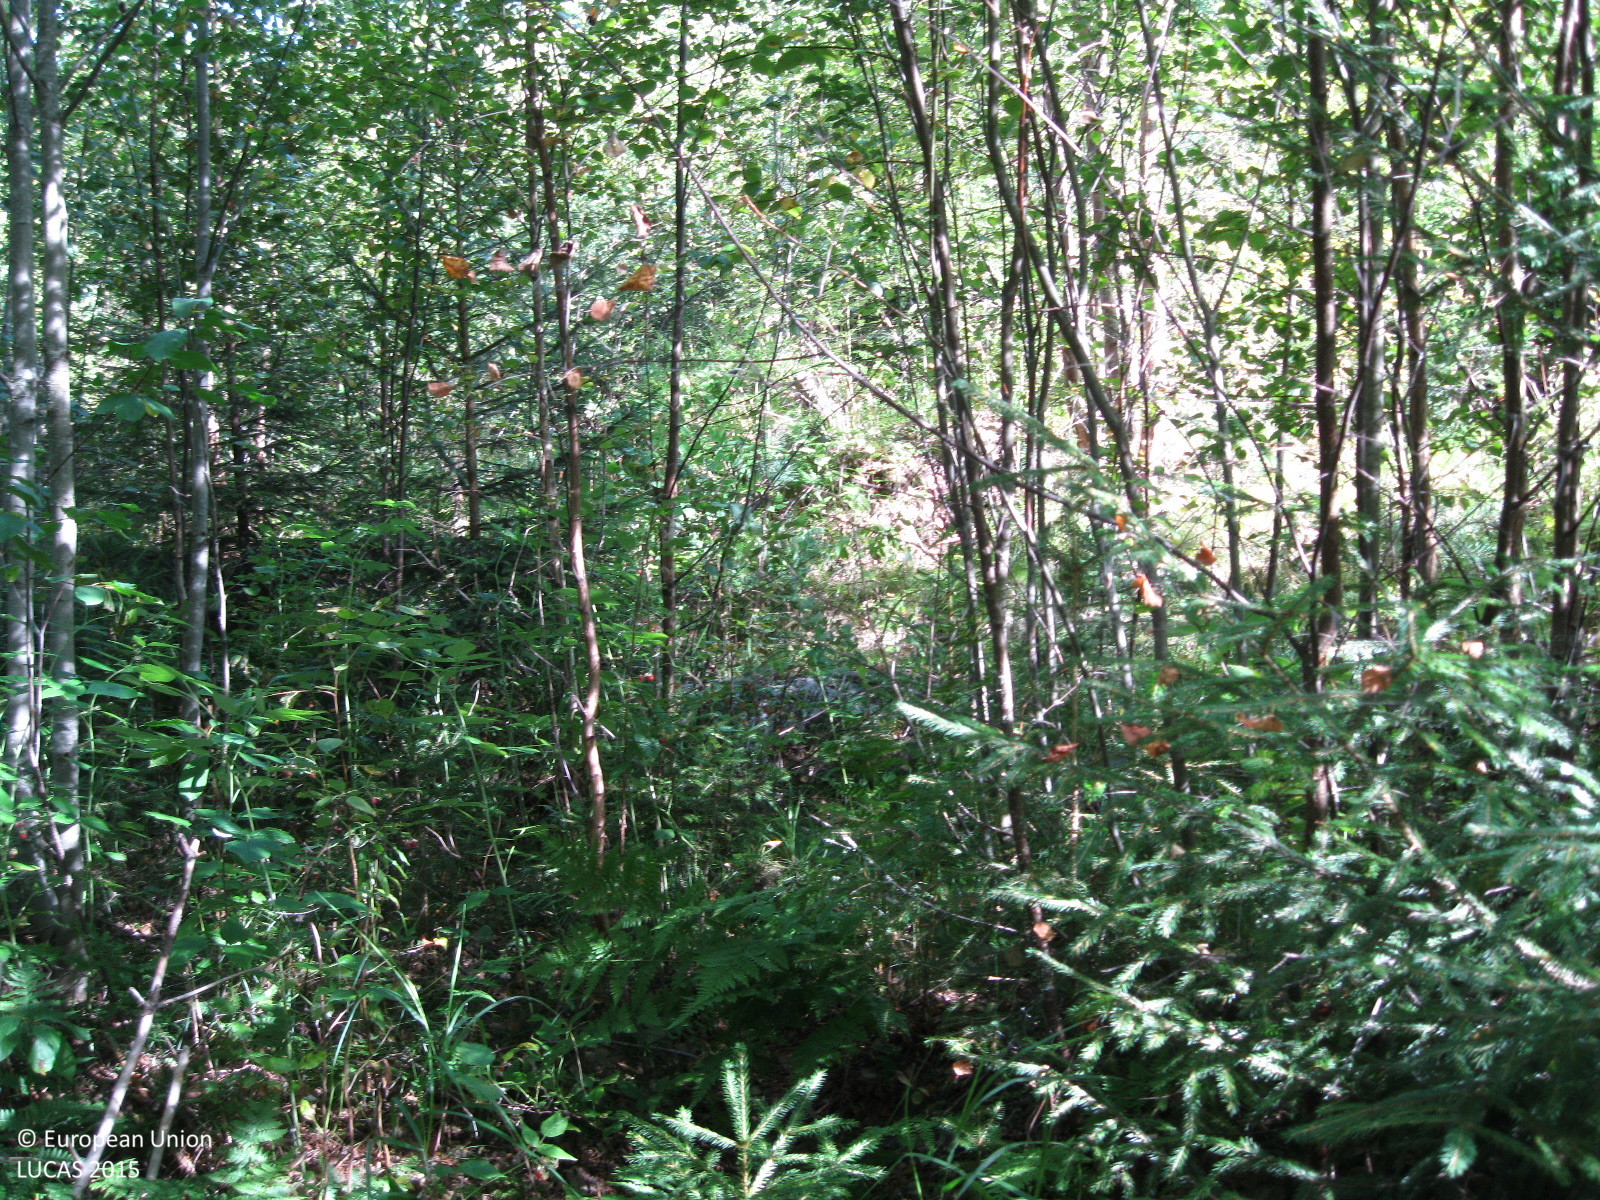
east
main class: Woodland
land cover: Pine dominated mixed woodland
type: boreal forest
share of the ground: > 75 %
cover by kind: broadleaved forest trees 70 %, coniferous forest trees 25 %, shrubs 5 %
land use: Forestry
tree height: > 5 m
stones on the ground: < 10 %
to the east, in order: Pine dominated mixed woodland; Ditches and canals; Broadleaved woodland; Spruce dominated mixed woodland; Ditches and canals; Spruce dominated mixed woodland; Paved roads, cycling and walking lanes; Grassland with sparse tree/shrub cover; Spruce dominated mixed woodland; Inland fresh water bodies
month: August
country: FI
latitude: 61.4010
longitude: 25.1134
